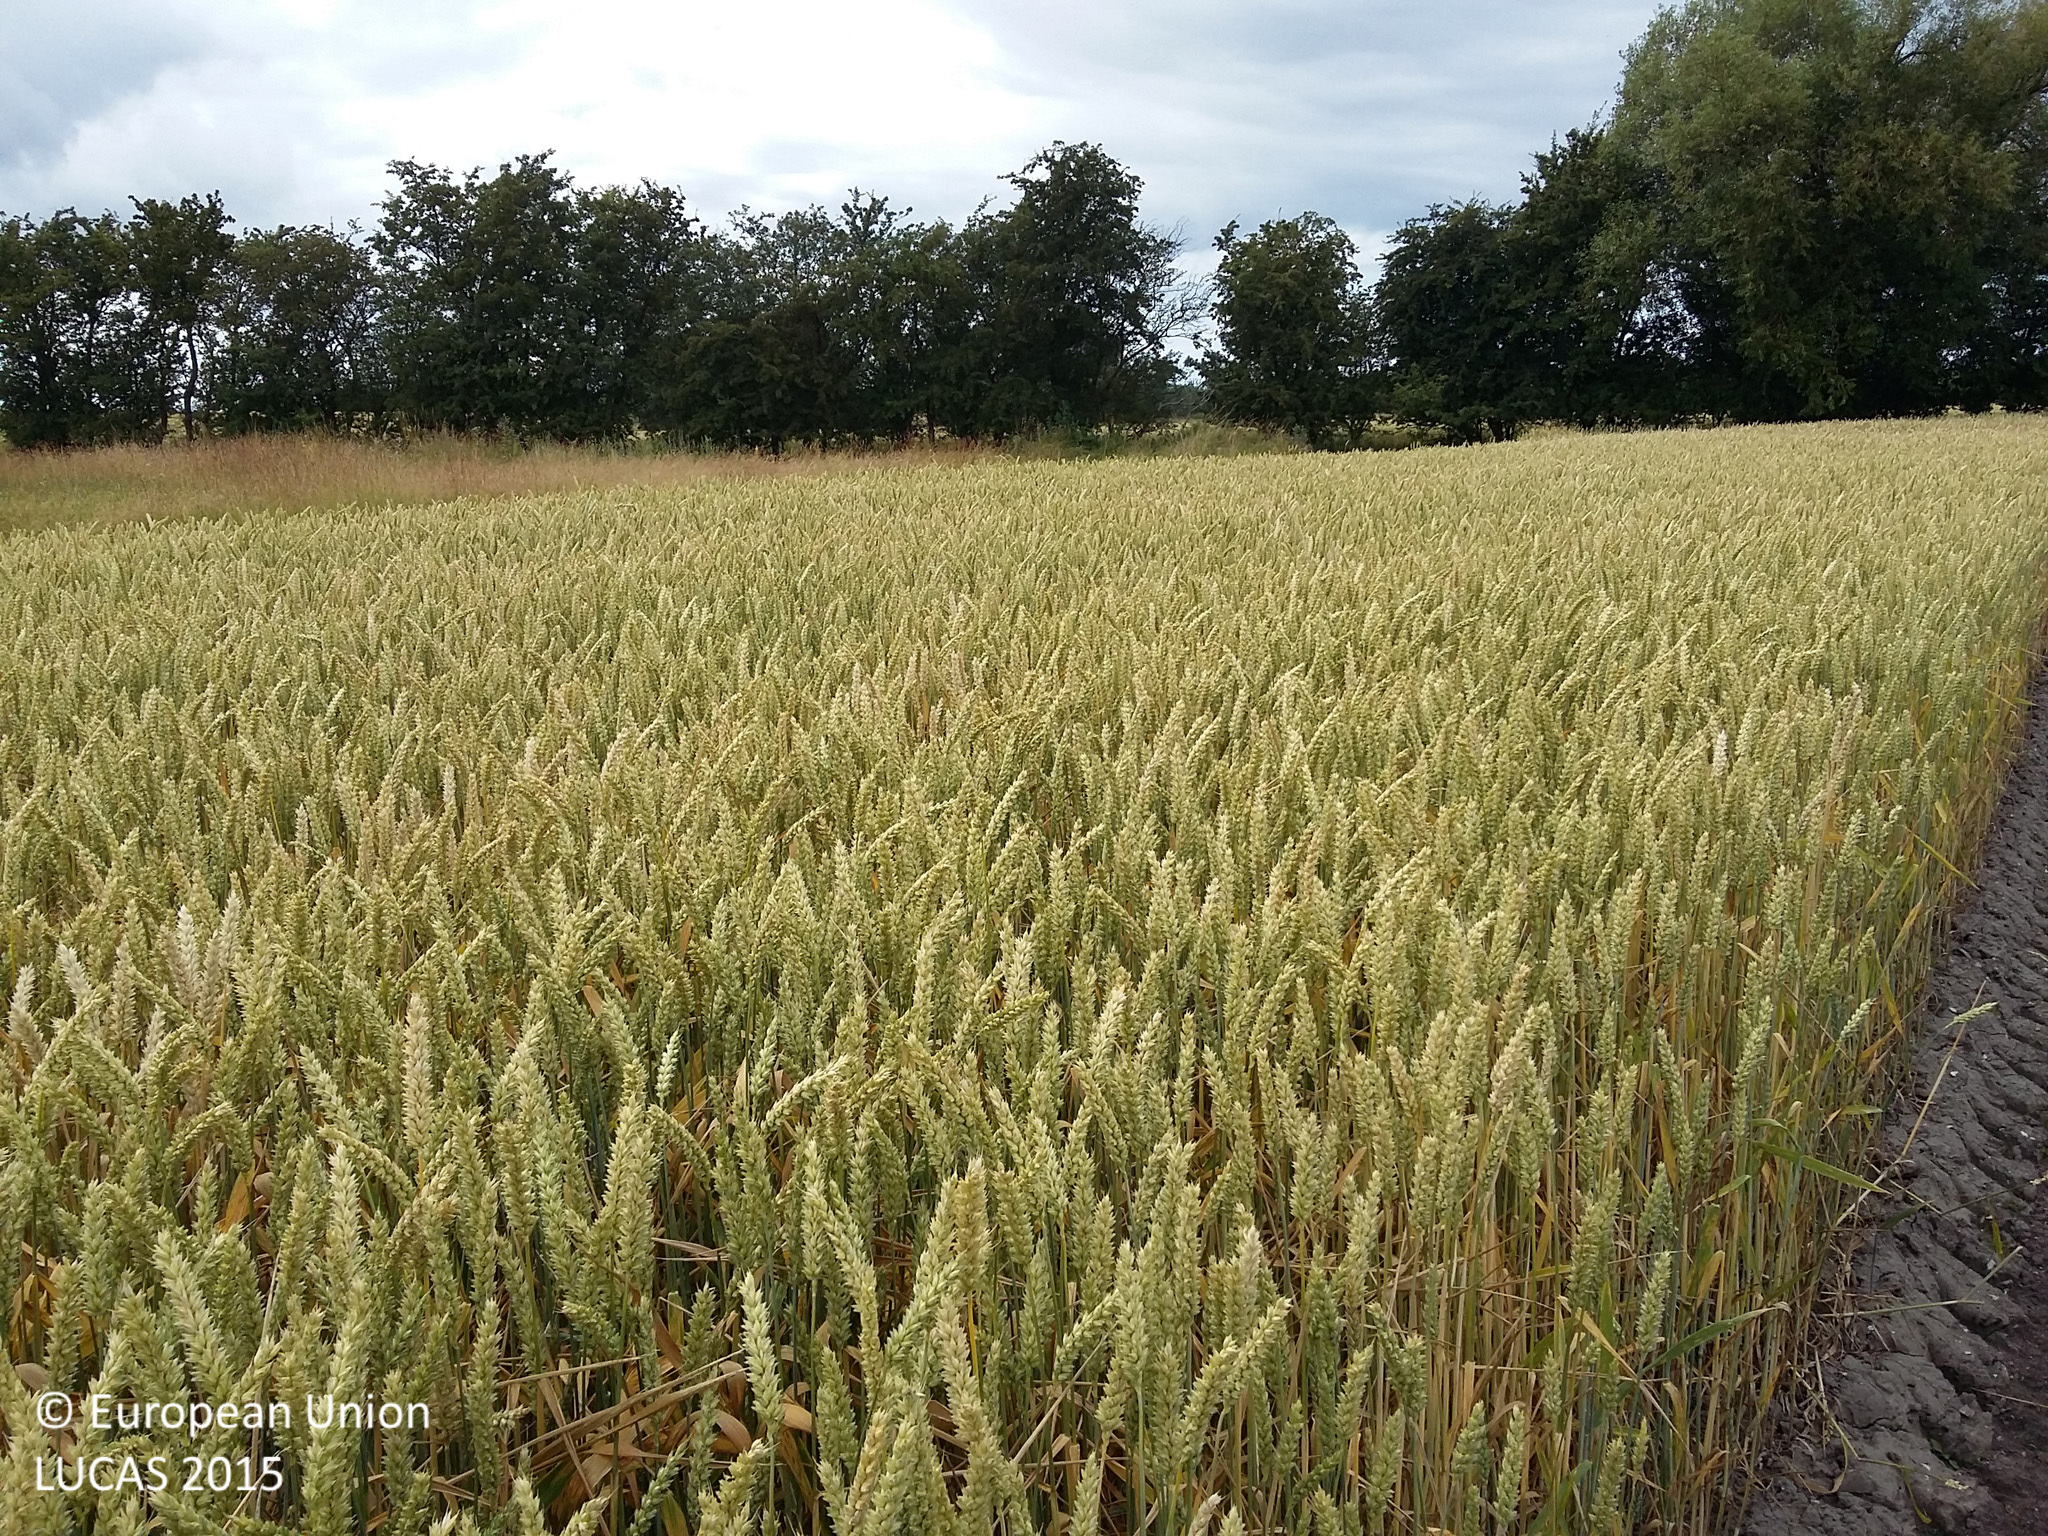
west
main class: Cropland
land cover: Common wheat
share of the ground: > 75 %
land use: Agriculture (excluding fallow land and kitchen gardens)
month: July
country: DK
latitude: 55.7470
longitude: 11.5438
